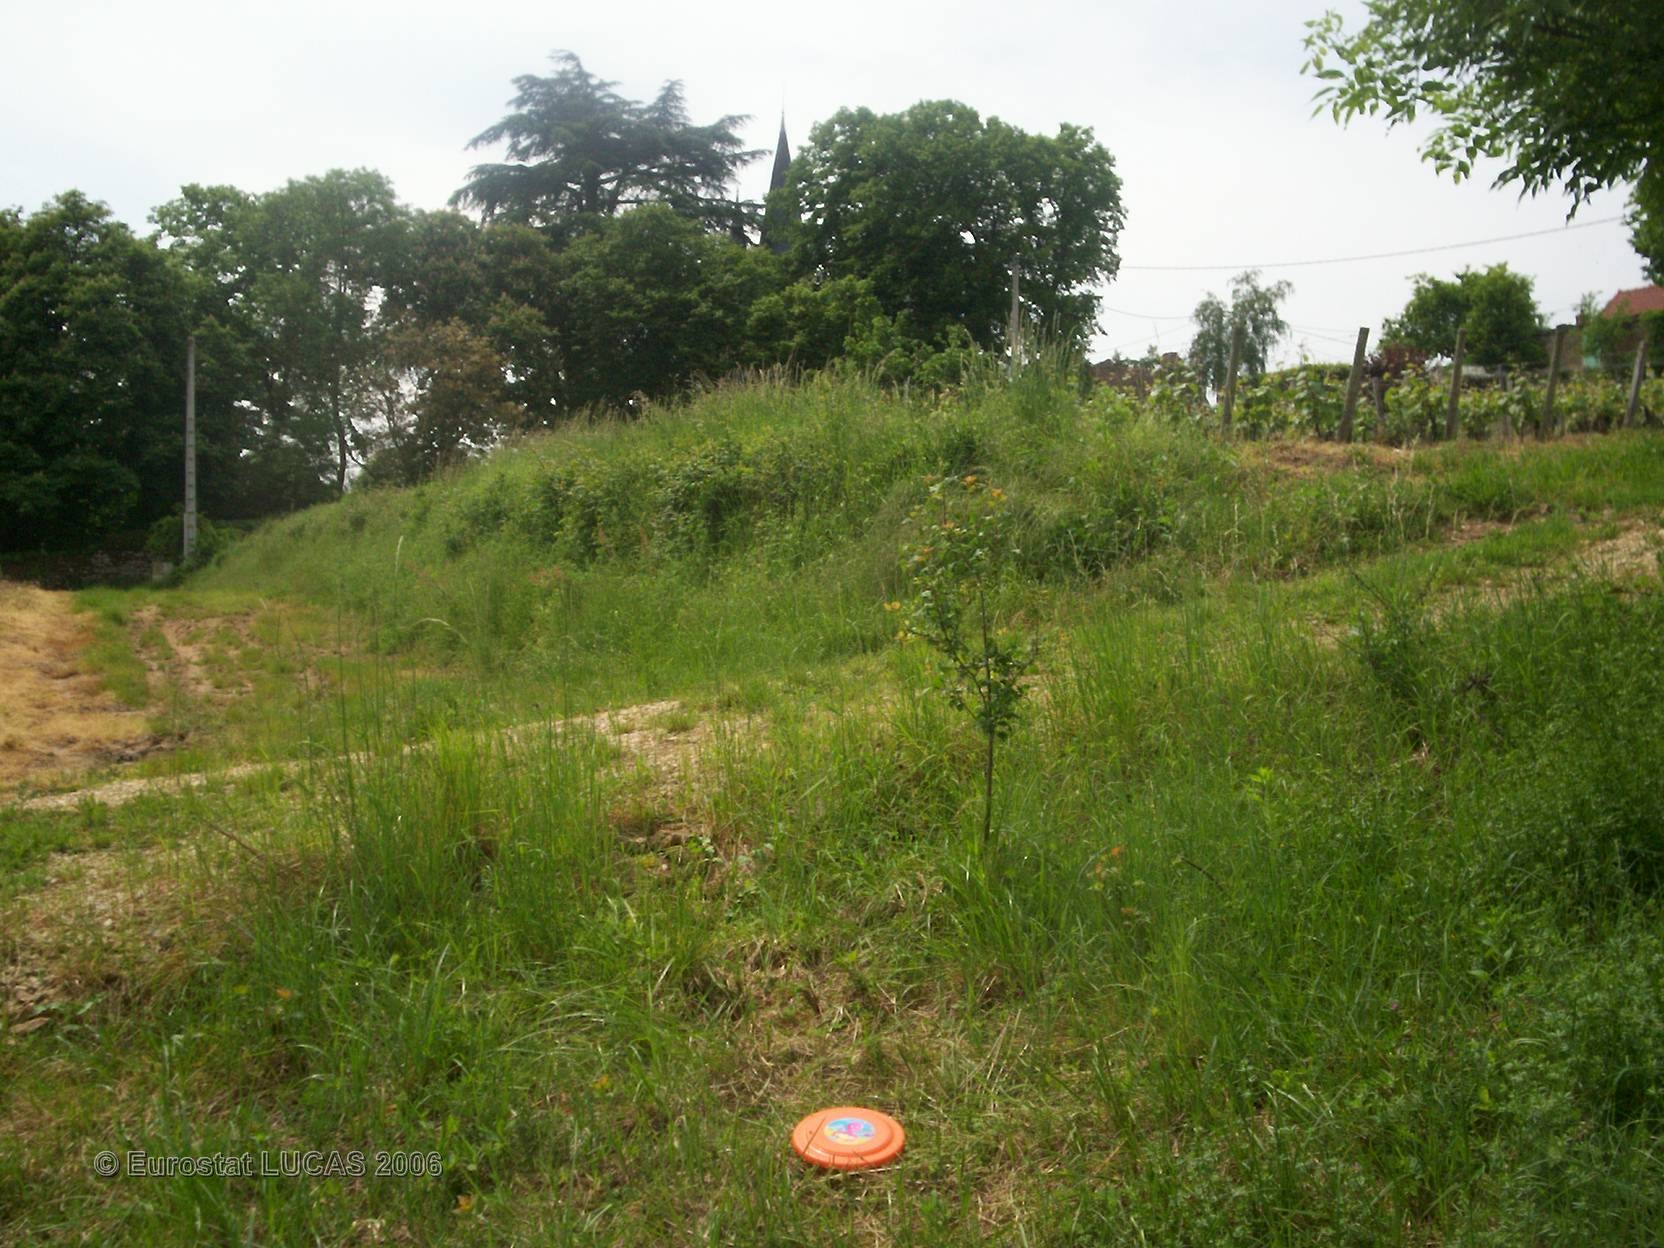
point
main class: Cropland
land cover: Apple fruit
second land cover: Grassland with sparse tree/shrub cover
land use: Kitchen garden
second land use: Residential
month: May
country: FR
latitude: 46.7253
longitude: 4.7020
